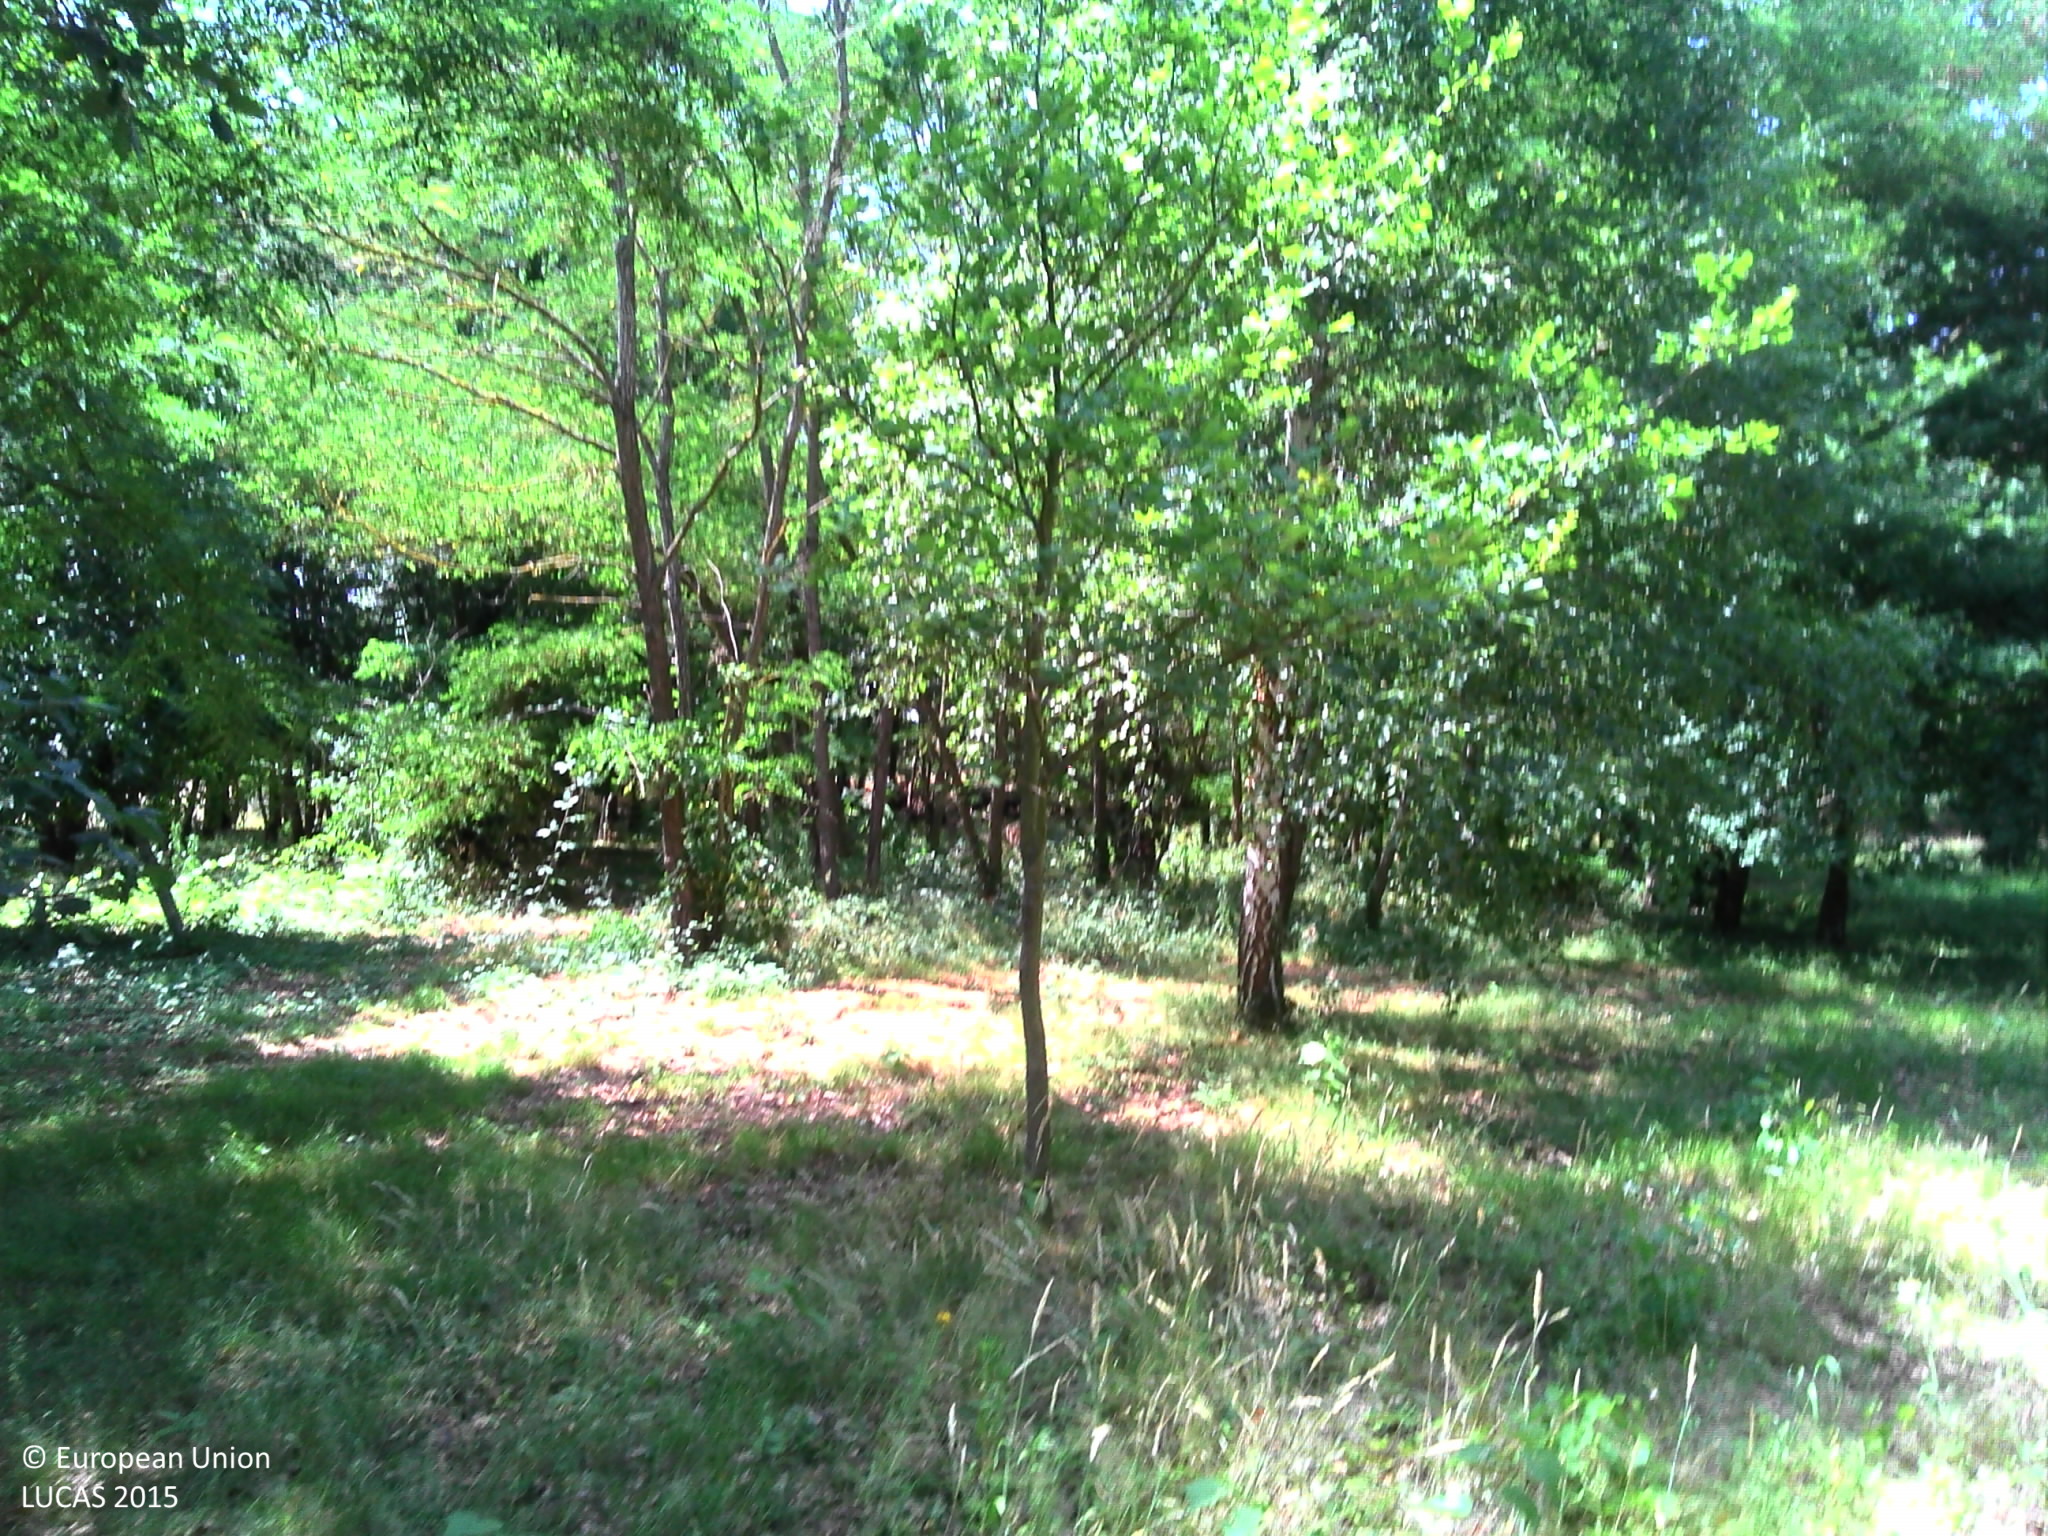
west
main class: Grassland
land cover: Grassland with sparse tree/shrub cover
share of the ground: > 75 %
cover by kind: herbaceous plants 95 %, broadleaved forest trees 5 %
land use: Agriculture (excluding fallow land and kitchen gardens)
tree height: < 5 m
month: July
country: FR
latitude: 43.0523
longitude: 1.6458
